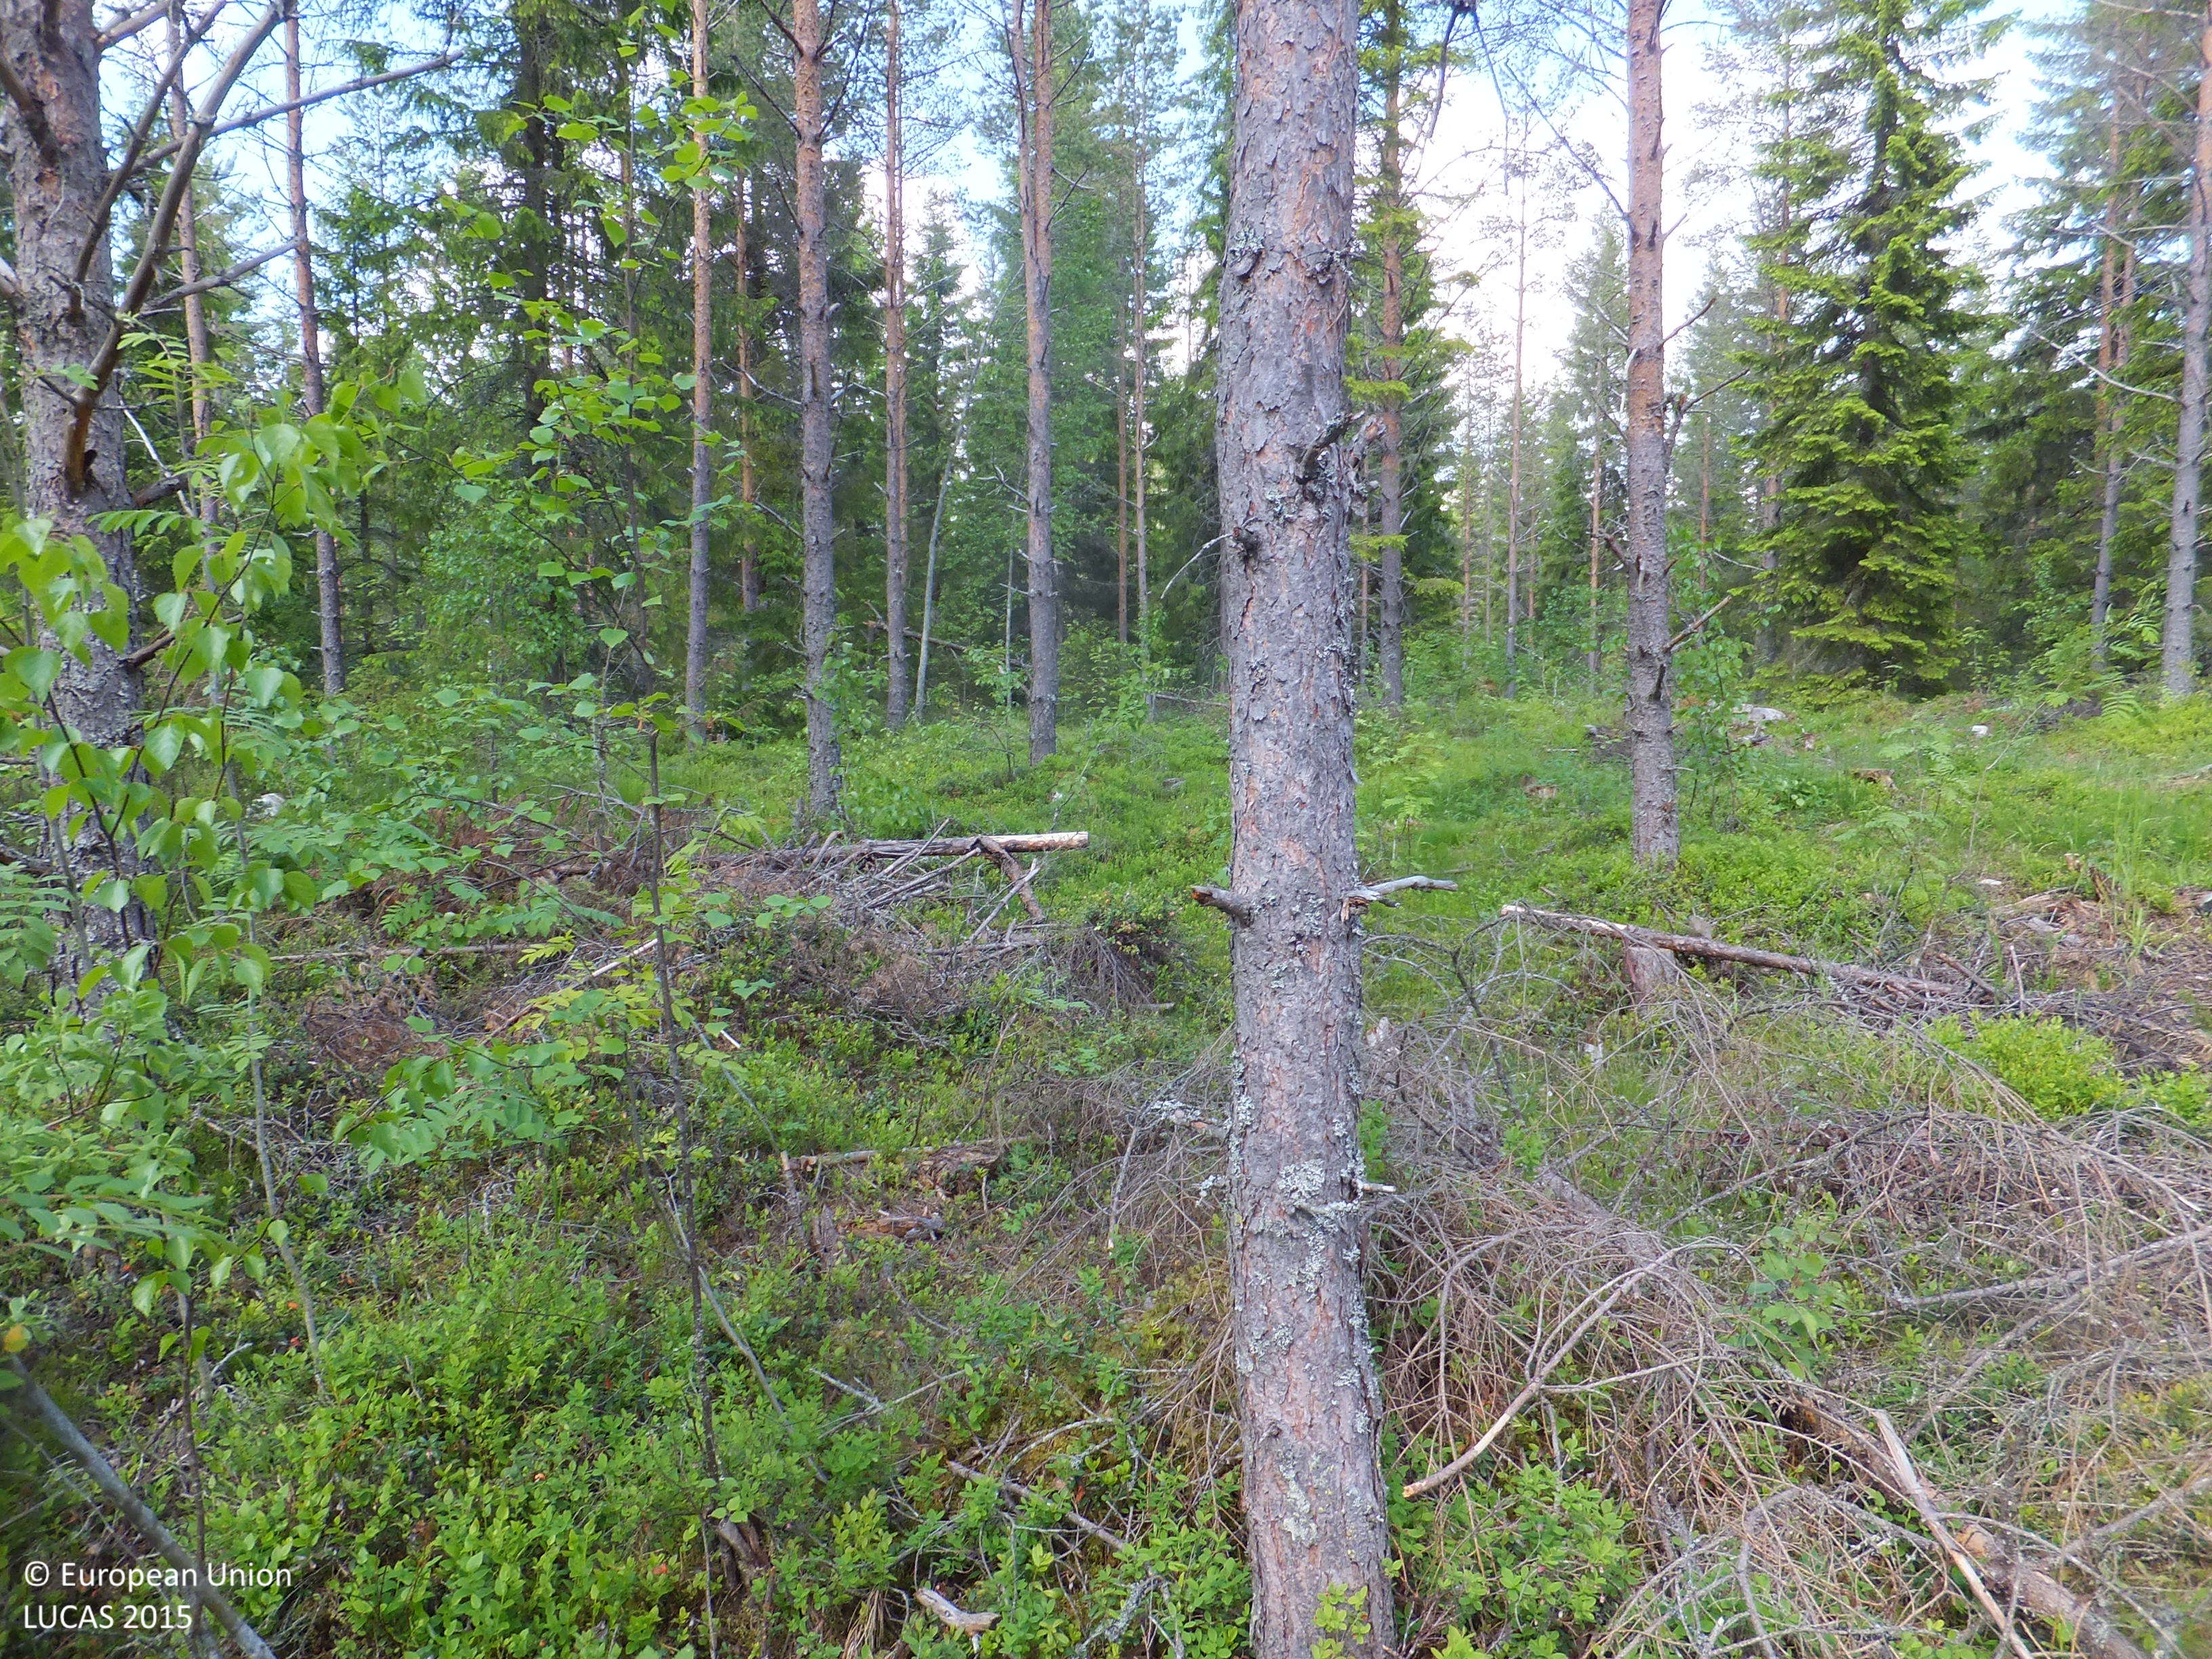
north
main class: Woodland
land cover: Other mixed woodland
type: boreal forest
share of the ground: > 75 %
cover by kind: coniferous forest trees 55 %, broadleaved forest trees 20 %, shrubs 15 %, herbaceous plants 5 %, lichens and mosses 5 %
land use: Forestry
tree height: > 5 m
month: June
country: FI
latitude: 63.5617
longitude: 24.1033
